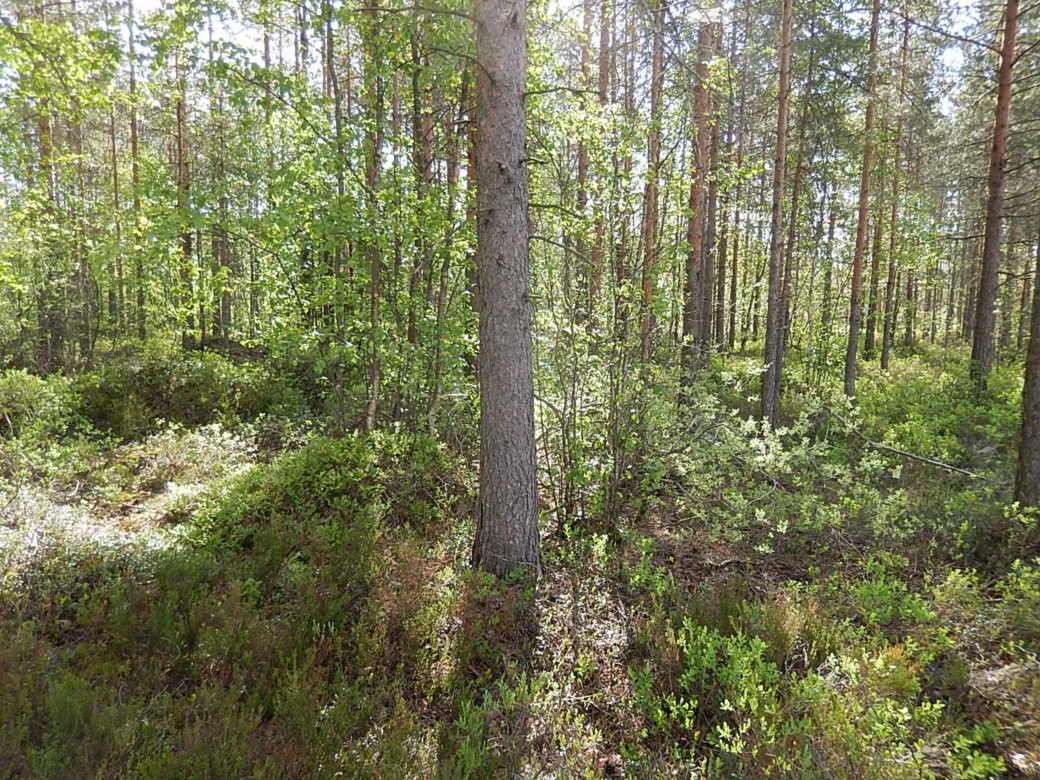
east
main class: Woodland
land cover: Pine dominated coniferous woodland
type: boreal forest
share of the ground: > 75 %
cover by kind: coniferous forest trees 75 %, shrubs 15 %, broadleaved forest trees 10 %
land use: Forestry
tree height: > 5 m
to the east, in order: Pine dominated coniferous woodland; Ditches and canals; Pine dominated coniferous woodland; Ditches and canals; Pine dominated coniferous woodland; Ditches and canals; Pine dominated coniferous woodland; Ditches and canals; Pine dominated coniferous woodland; Shruby margins; Electric lines; Shruby margins; Pine dominated coniferous woodland; Electric lines; Broadleaved woodland
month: June
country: FI
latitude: 61.9789
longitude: 22.2876
